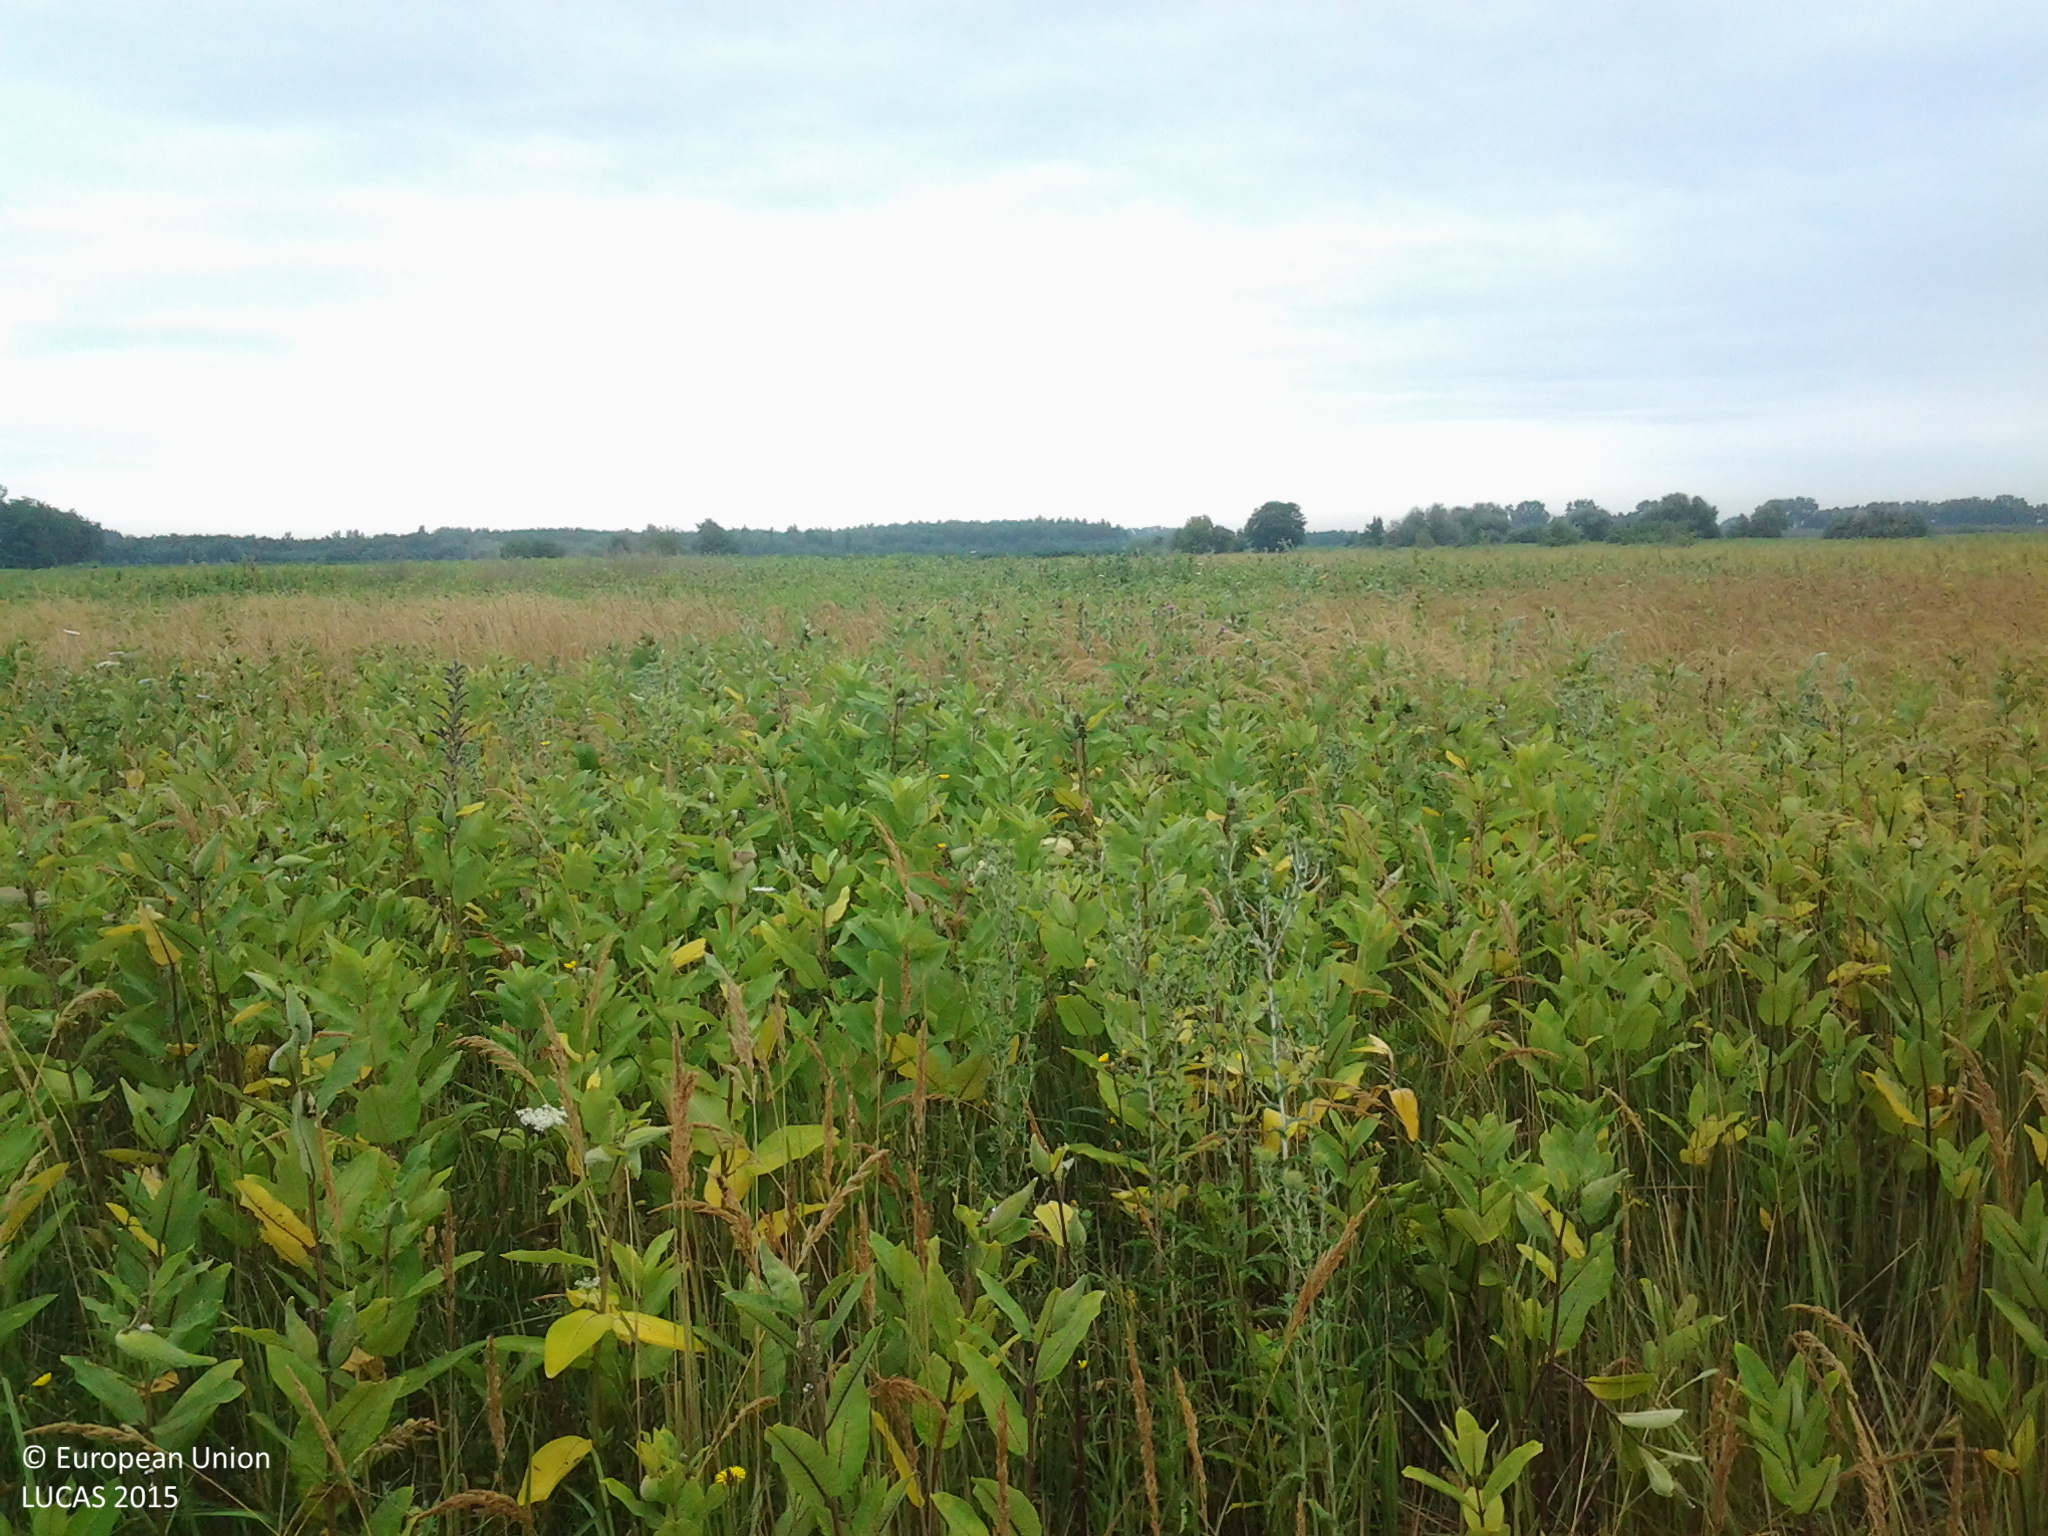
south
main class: Grassland
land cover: Spontaneously vegetated surfaces
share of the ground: > 75 %
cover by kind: herbaceous plants 100 %
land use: Semi-natural and natural areas not in use
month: July
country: HU
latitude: 46.9282
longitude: 19.2501
